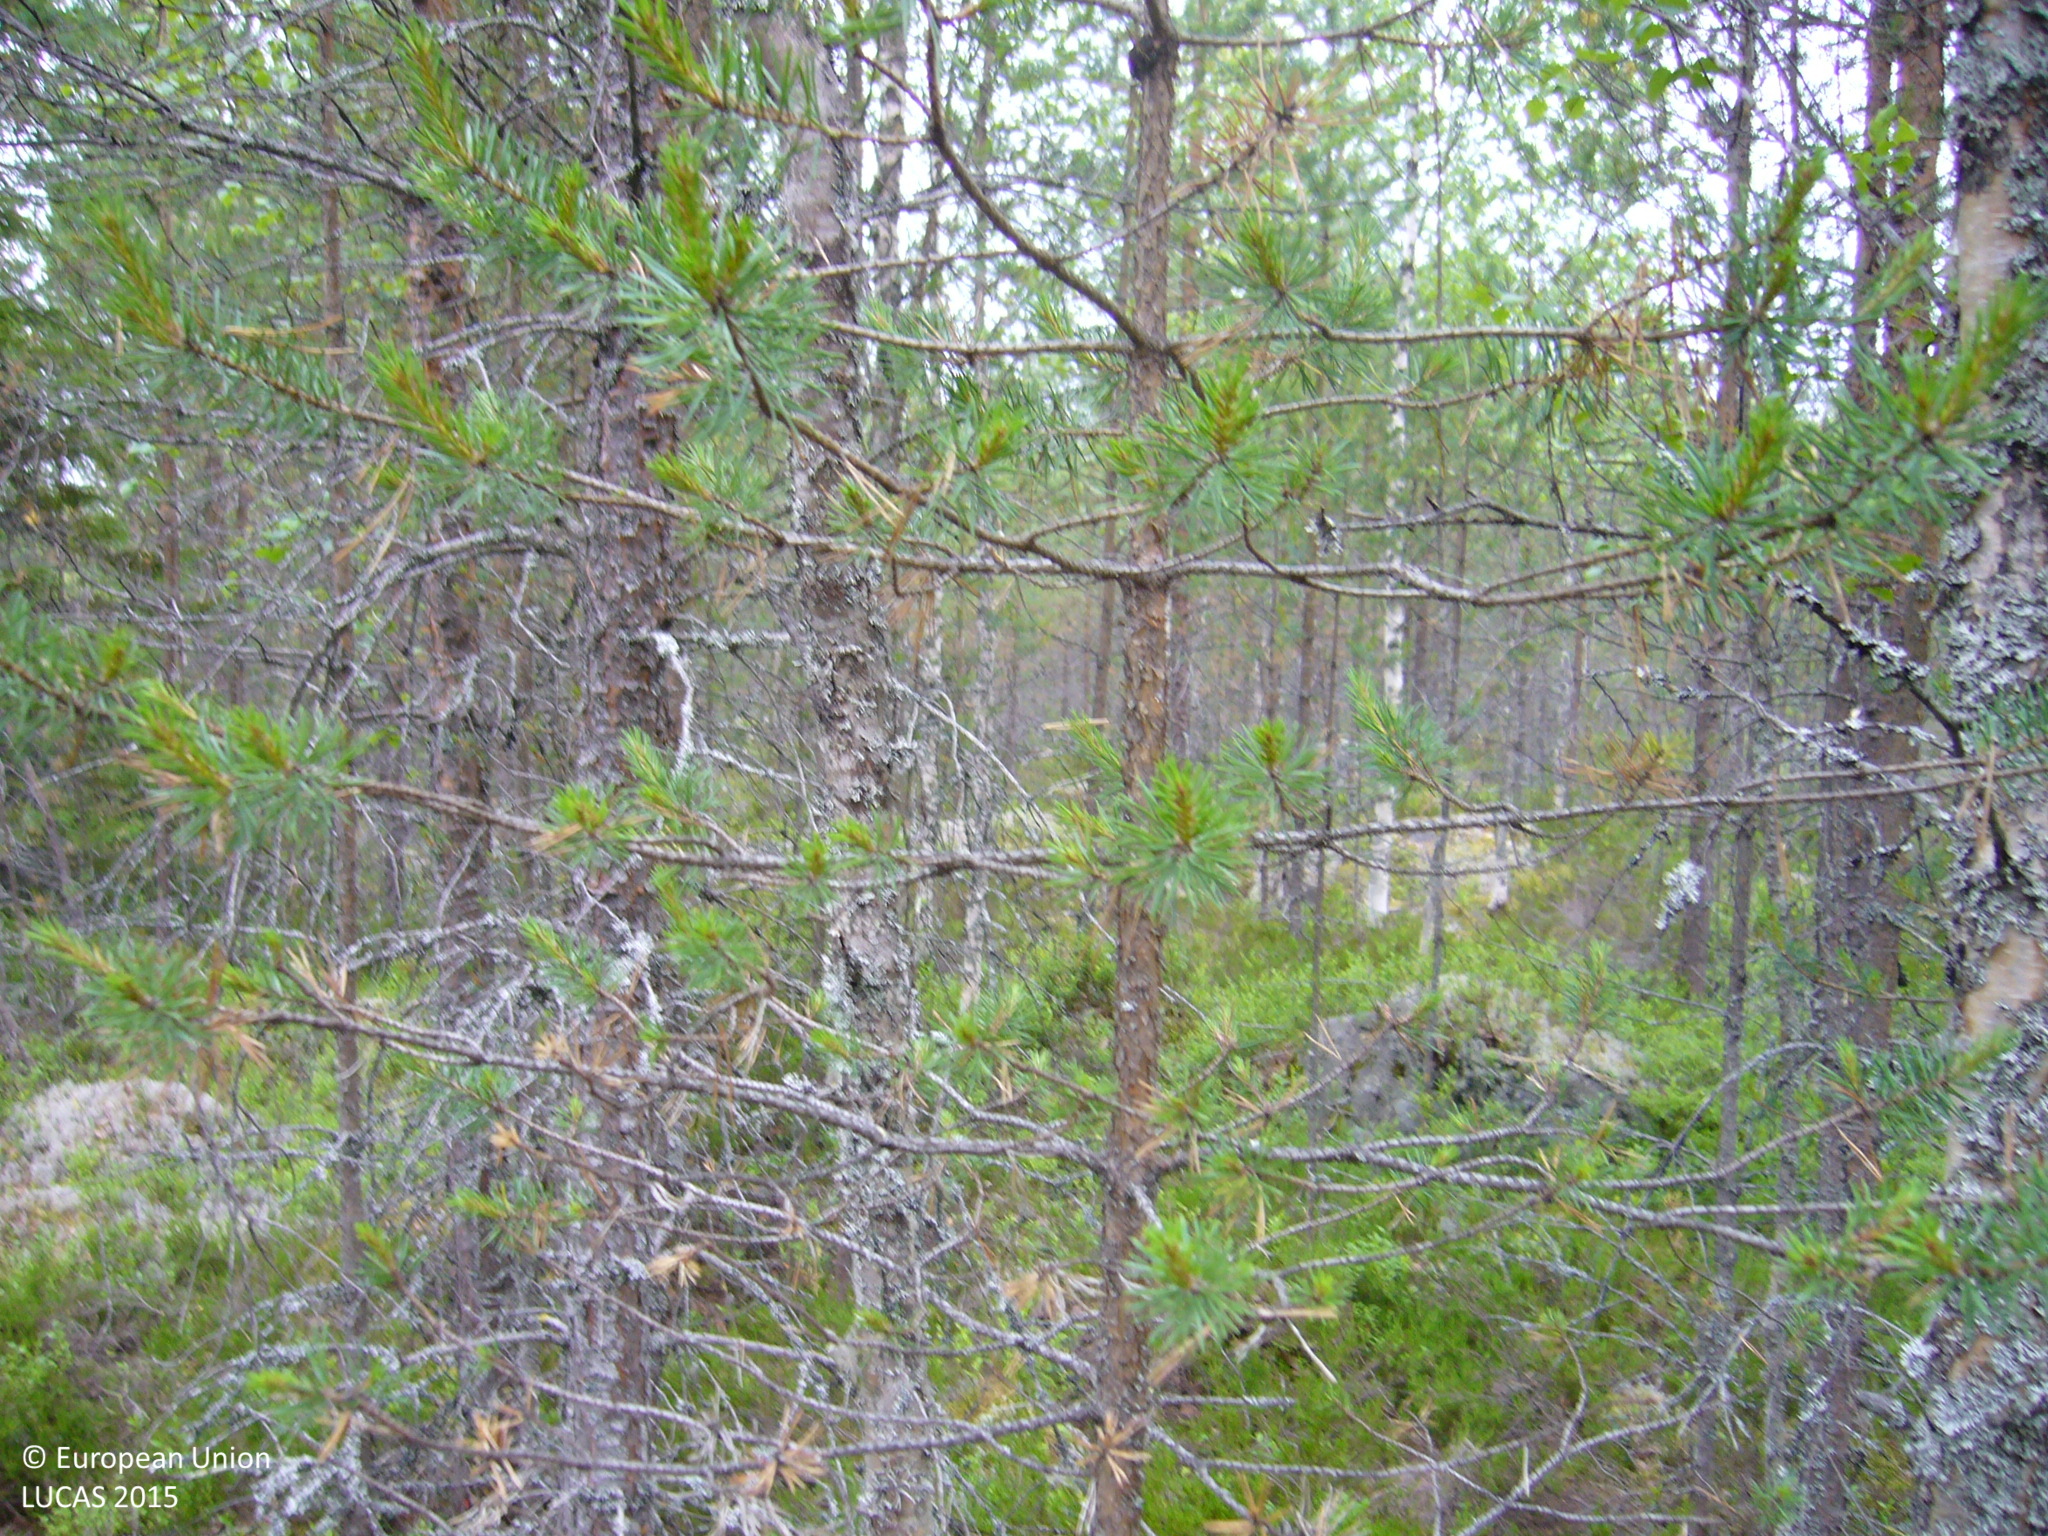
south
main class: Woodland
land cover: Pine dominated coniferous woodland
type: boreal forest
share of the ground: 50 - 75 %
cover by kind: coniferous forest trees 50 %, shrubs 35 %, broadleaved forest trees 15 %
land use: Forestry
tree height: > 5 m
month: July
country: FI
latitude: 63.4191
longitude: 25.7527
